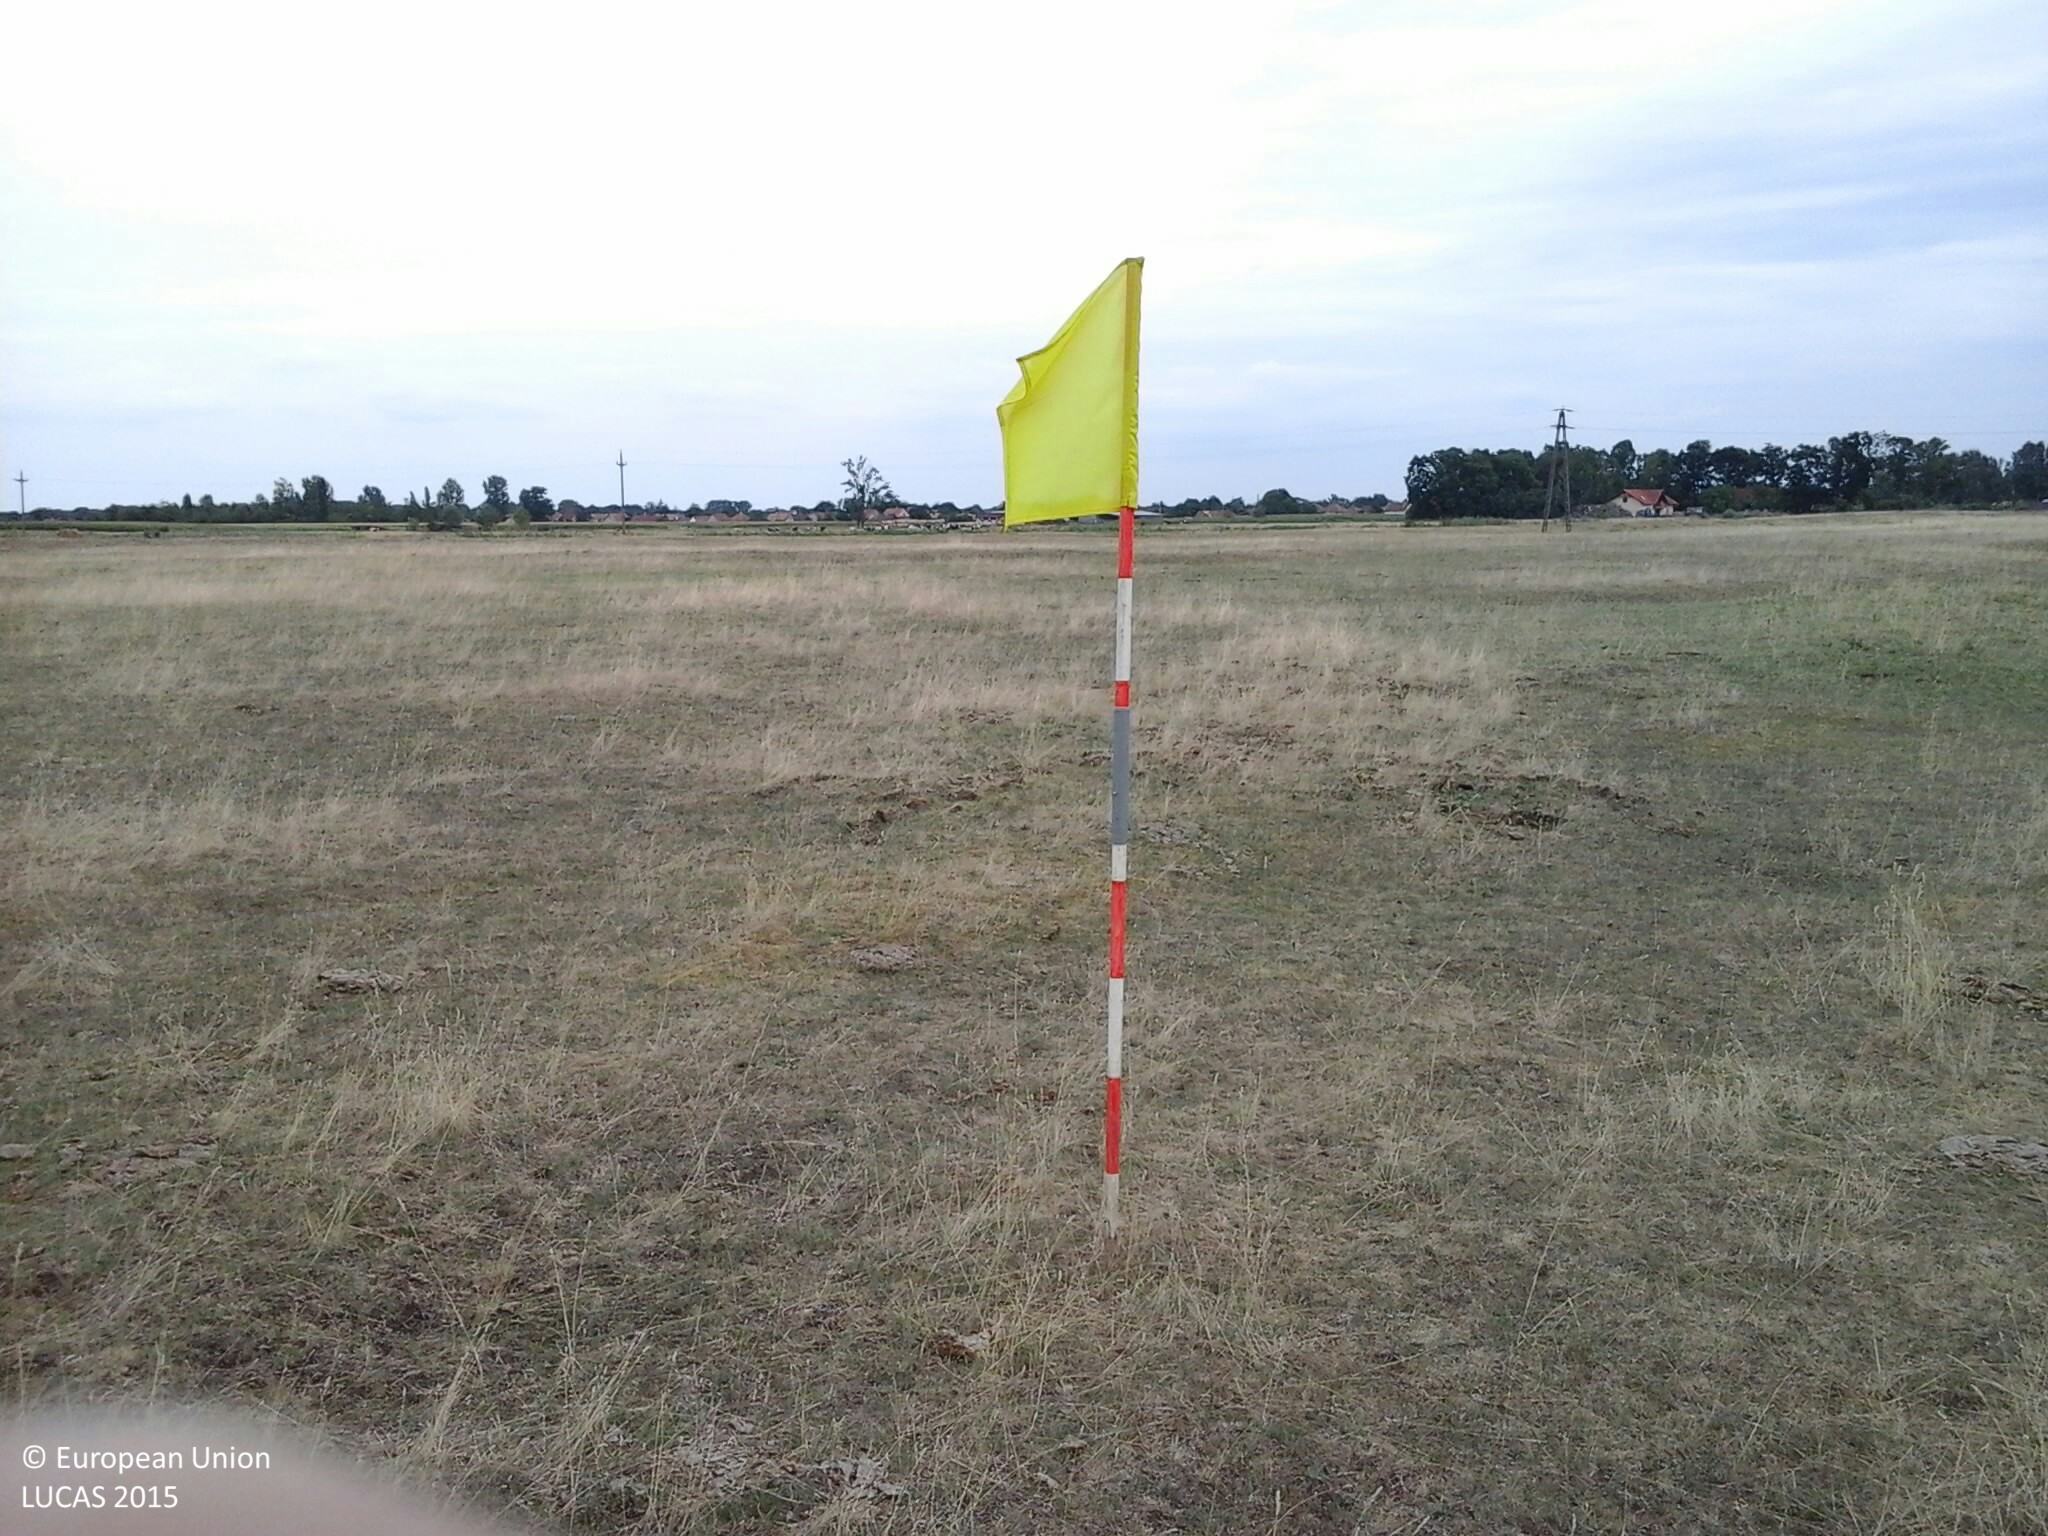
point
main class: Grassland
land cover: Grassland without tree/shrub cover
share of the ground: > 75 %
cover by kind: herbaceous plants 100 %
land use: Agriculture (excluding fallow land and kitchen gardens)
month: July
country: HU
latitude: 47.8642
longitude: 21.4194
